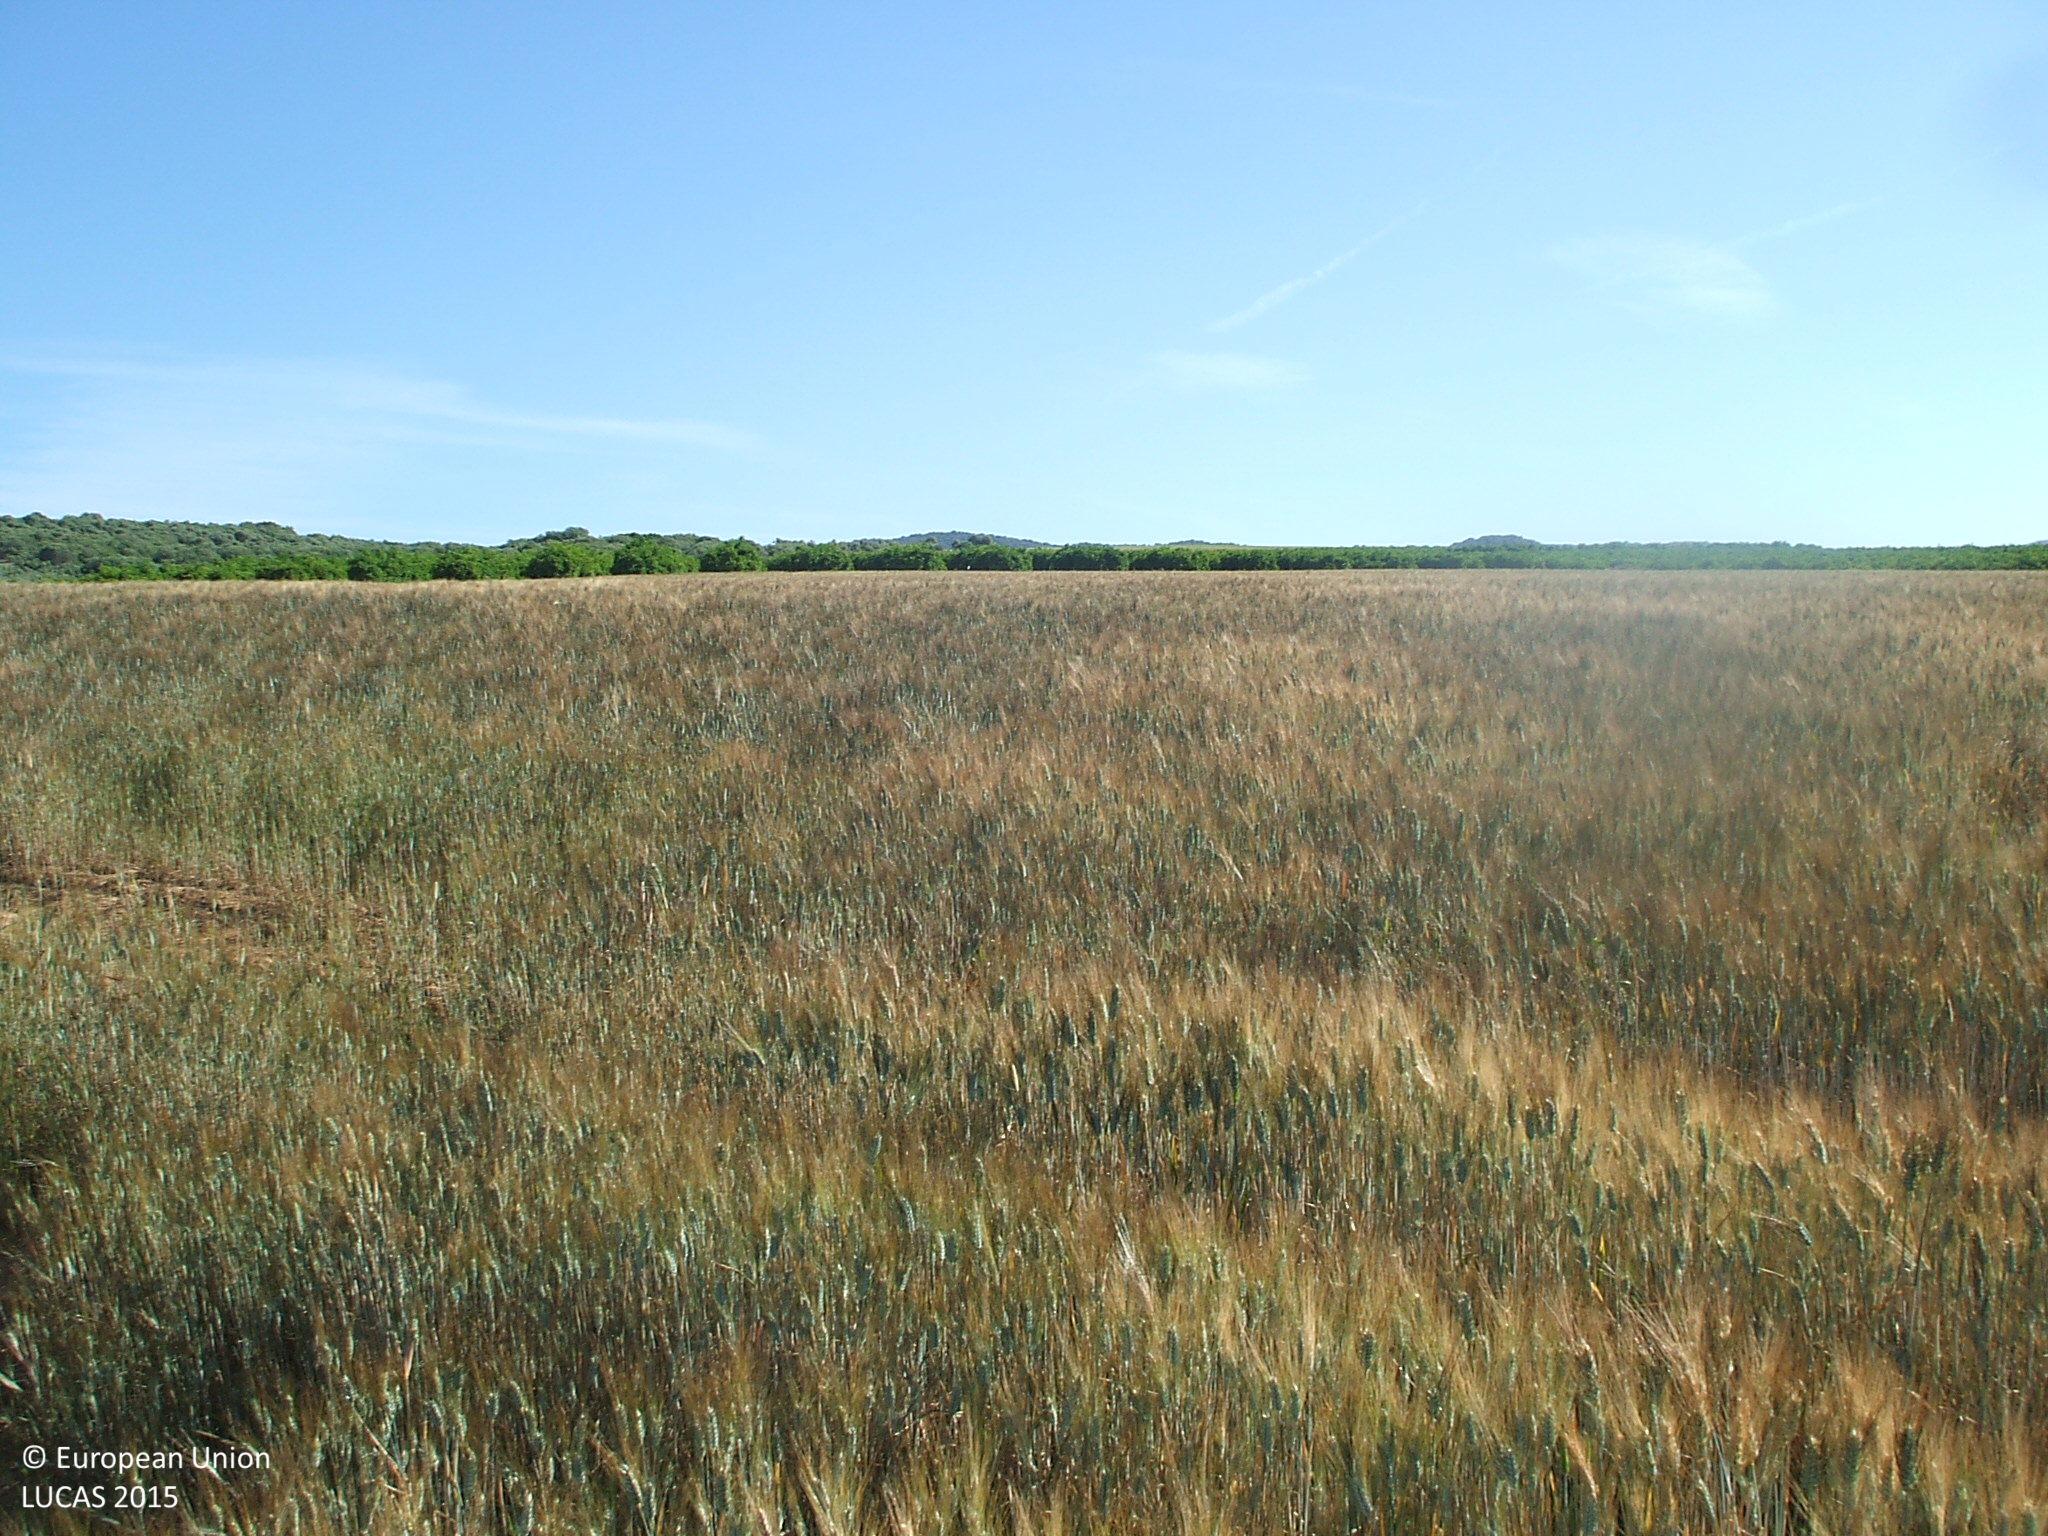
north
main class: Cropland
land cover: Common wheat
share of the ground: > 75 %
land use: Agriculture (excluding fallow land and kitchen gardens)
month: April
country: ES
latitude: 37.7268
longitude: -5.4634
